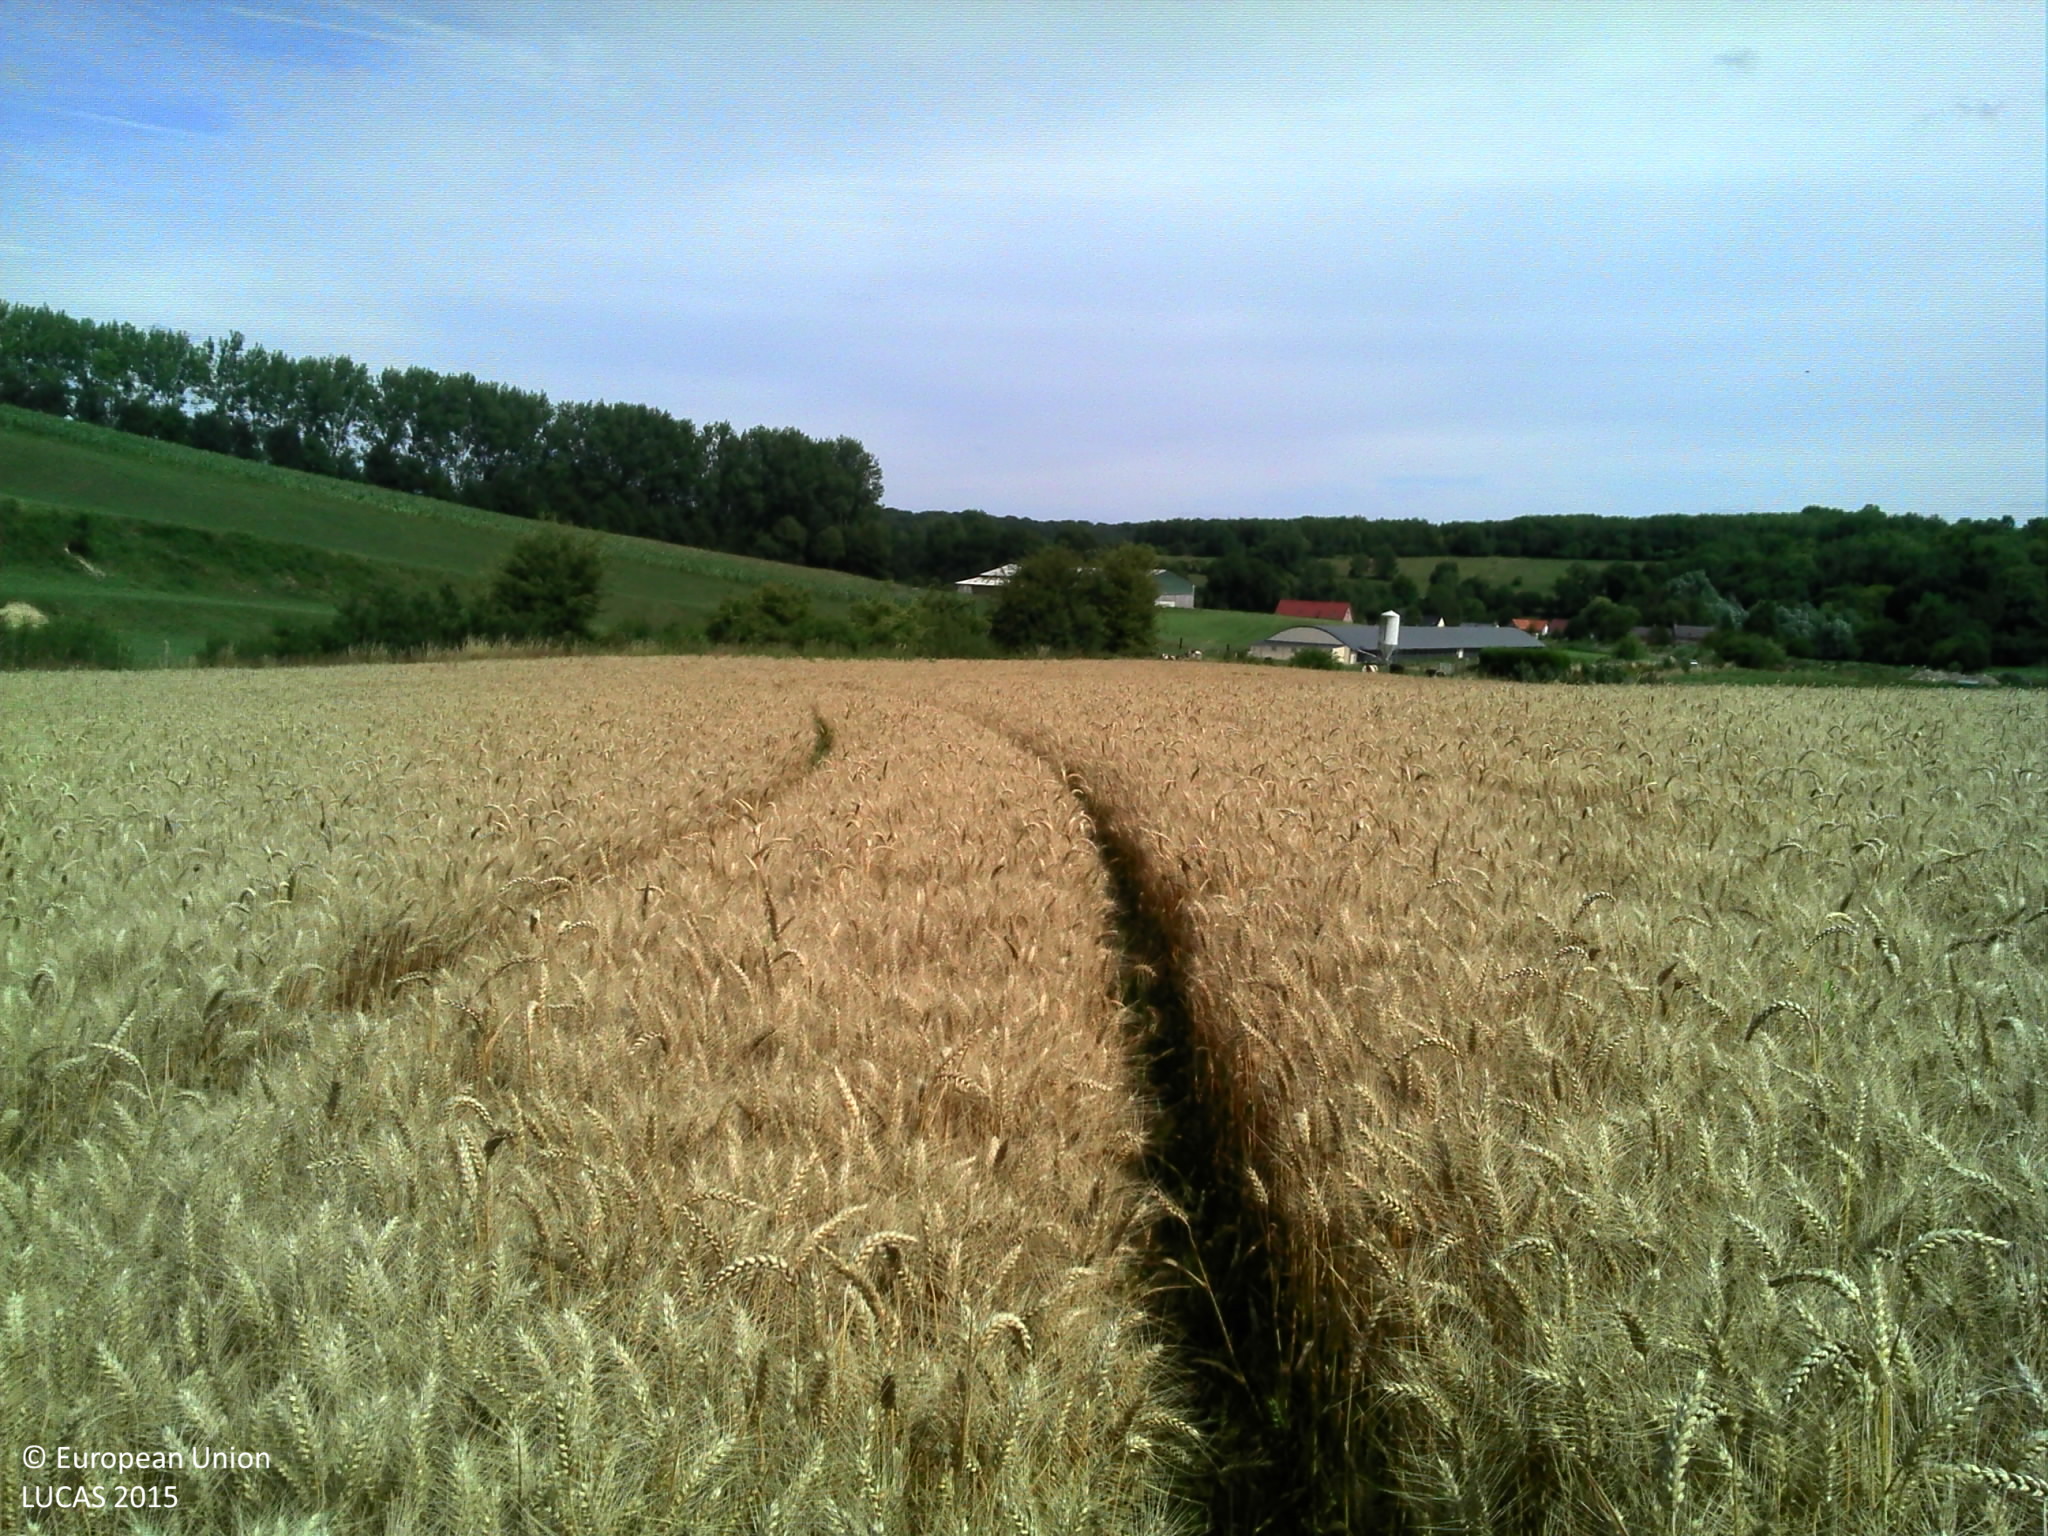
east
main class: Cropland
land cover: Common wheat
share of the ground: > 75 %
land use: Agriculture (excluding fallow land and kitchen gardens)
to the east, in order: Common wheat; Grass margins; Abandoned hedges; Spontaneously vegetated surfaces; Fences; Grassland without tree/shrub cover
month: July
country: FR
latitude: 50.1529
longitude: 2.2182
